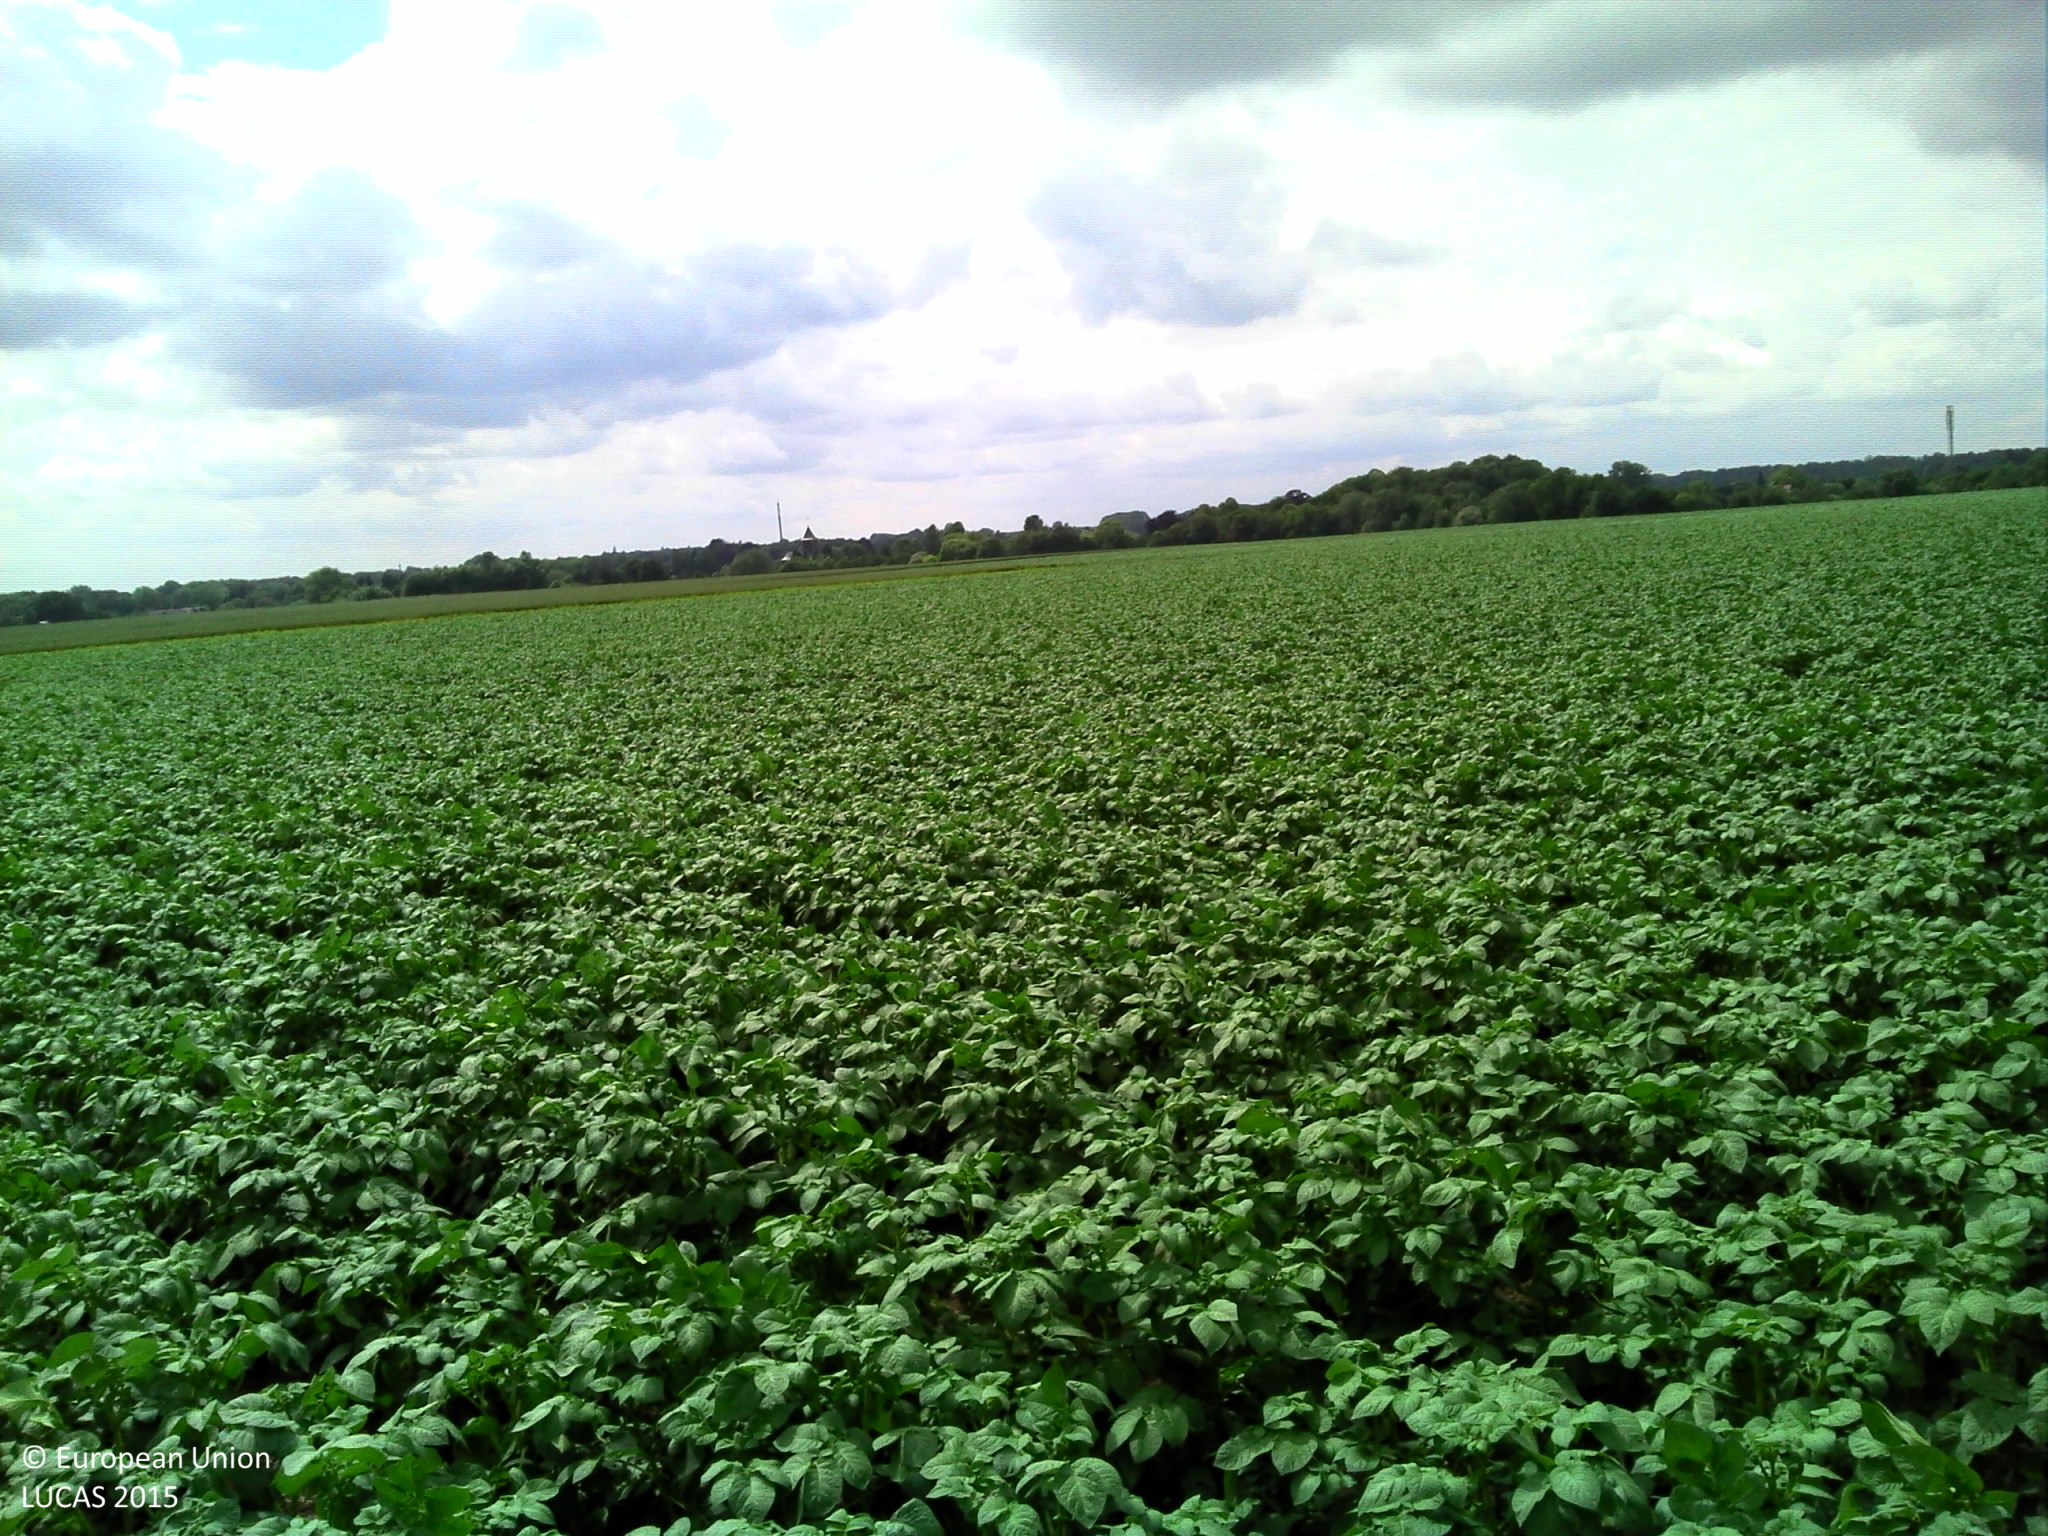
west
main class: Cropland
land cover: Potatoes
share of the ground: > 75 %
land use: Agriculture (excluding fallow land and kitchen gardens)
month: June
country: BE
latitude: 50.5146
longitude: 4.0289
